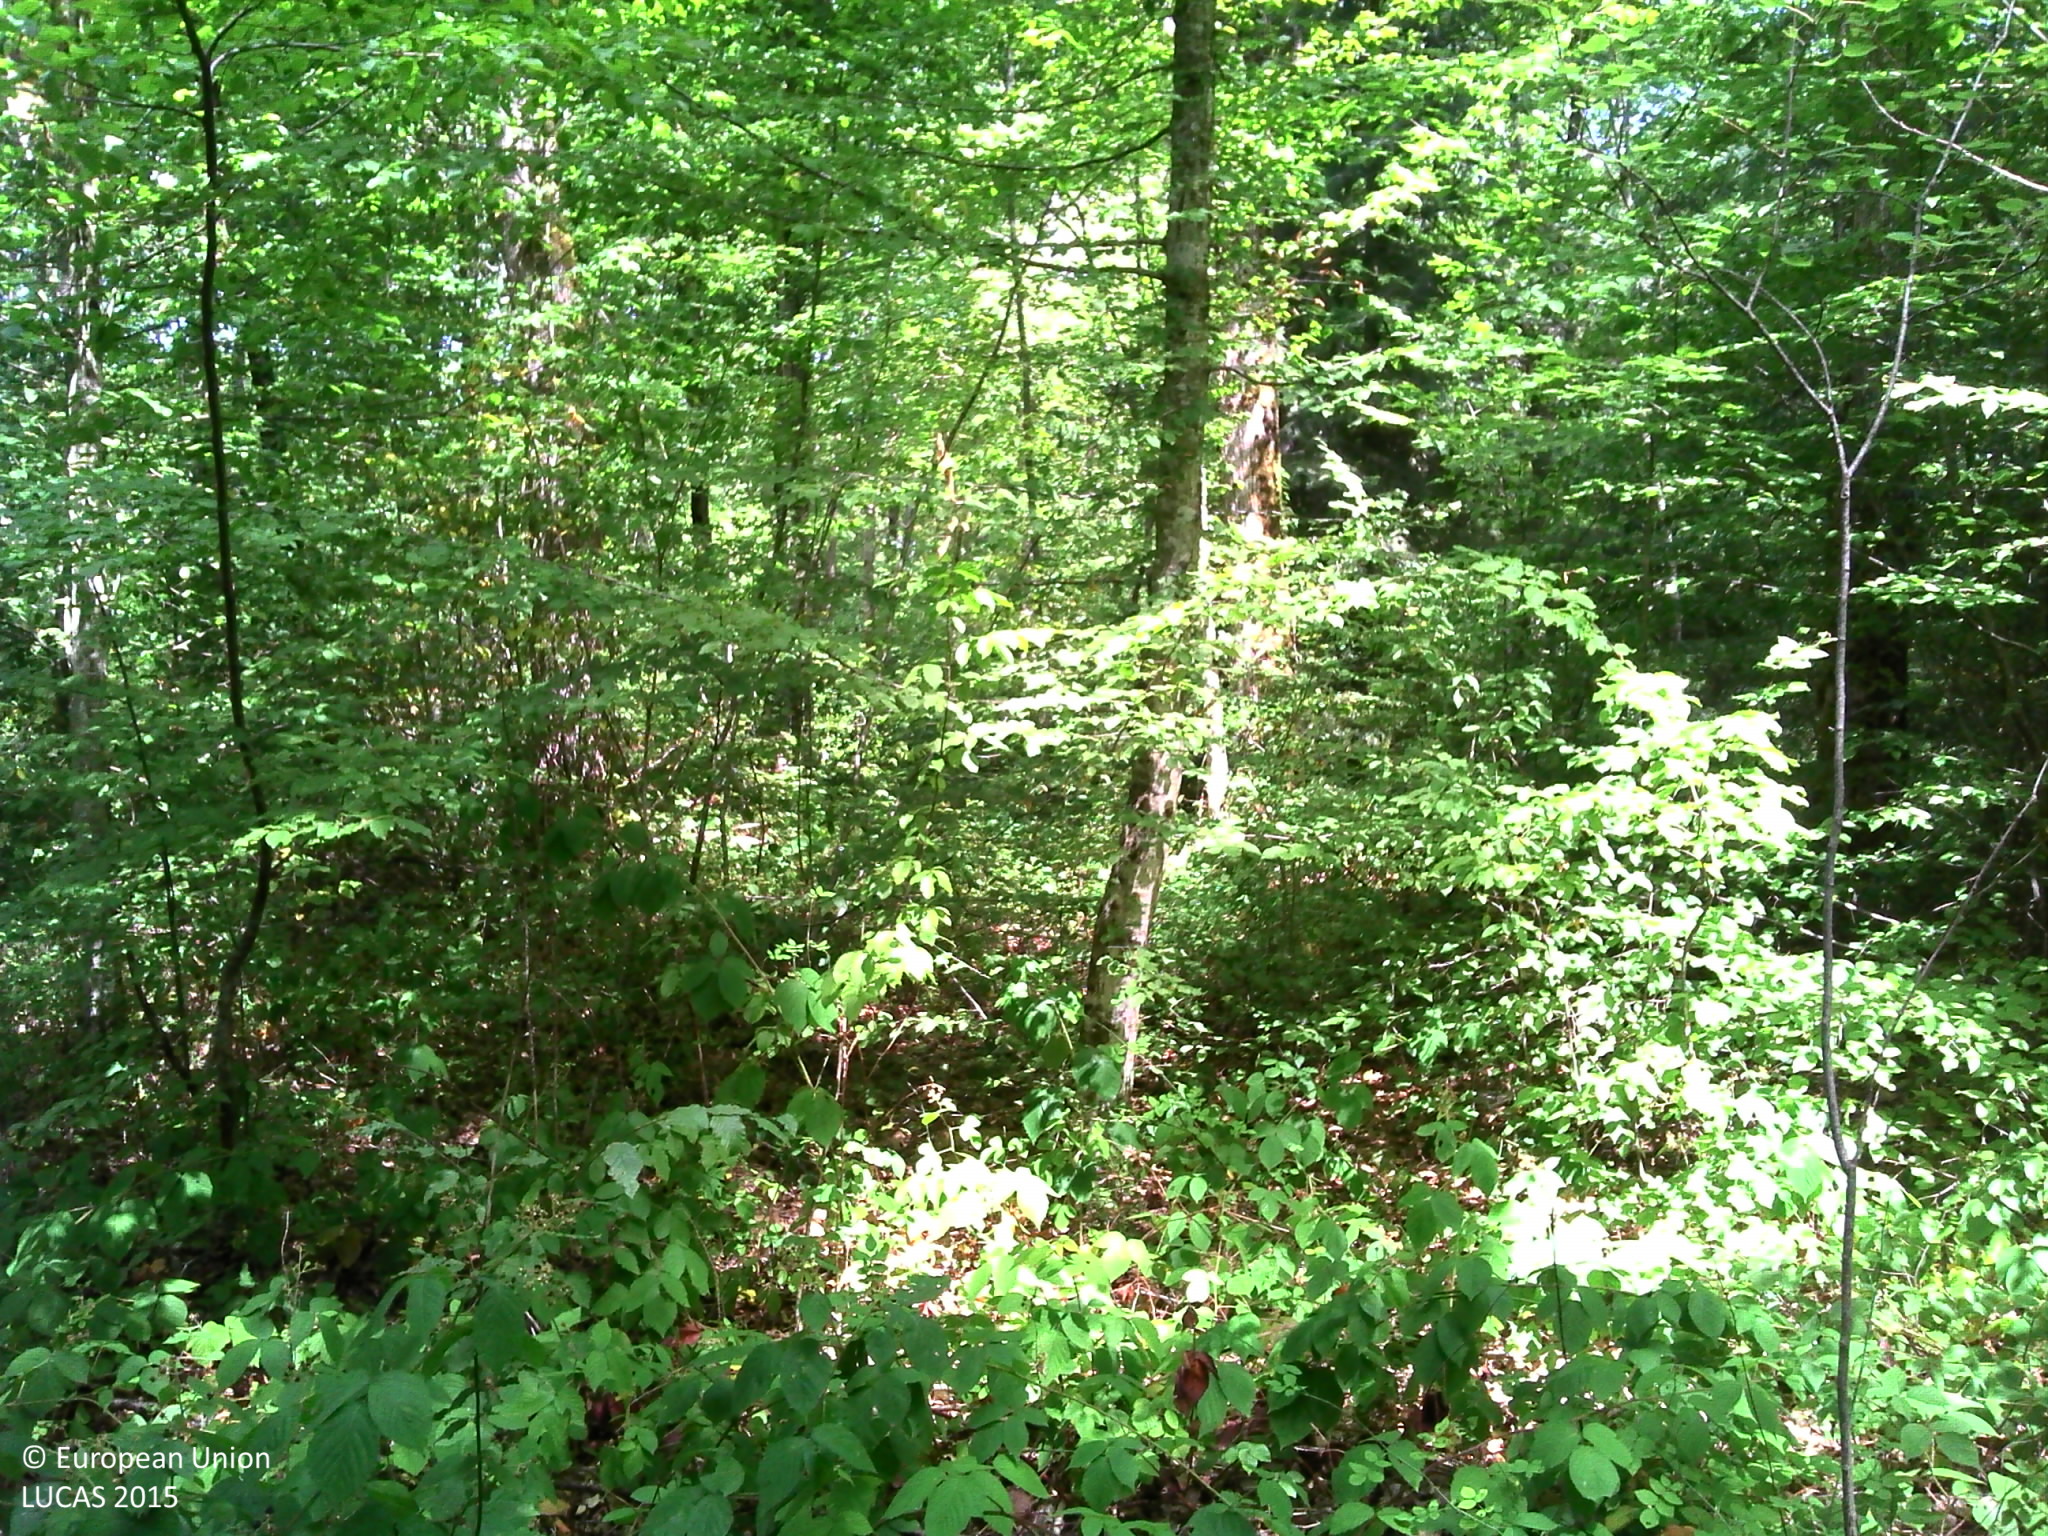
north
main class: Woodland
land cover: Broadleaved woodland
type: mesophytic deciduous forest
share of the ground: > 75 %
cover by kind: broadleaved forest trees 70 %, herbaceous plants 20 %, coniferous forest trees 5 %, lichens and mosses 5 %
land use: Forestry
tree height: > 5 m
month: July
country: FR
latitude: 47.7433
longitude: 5.2655
